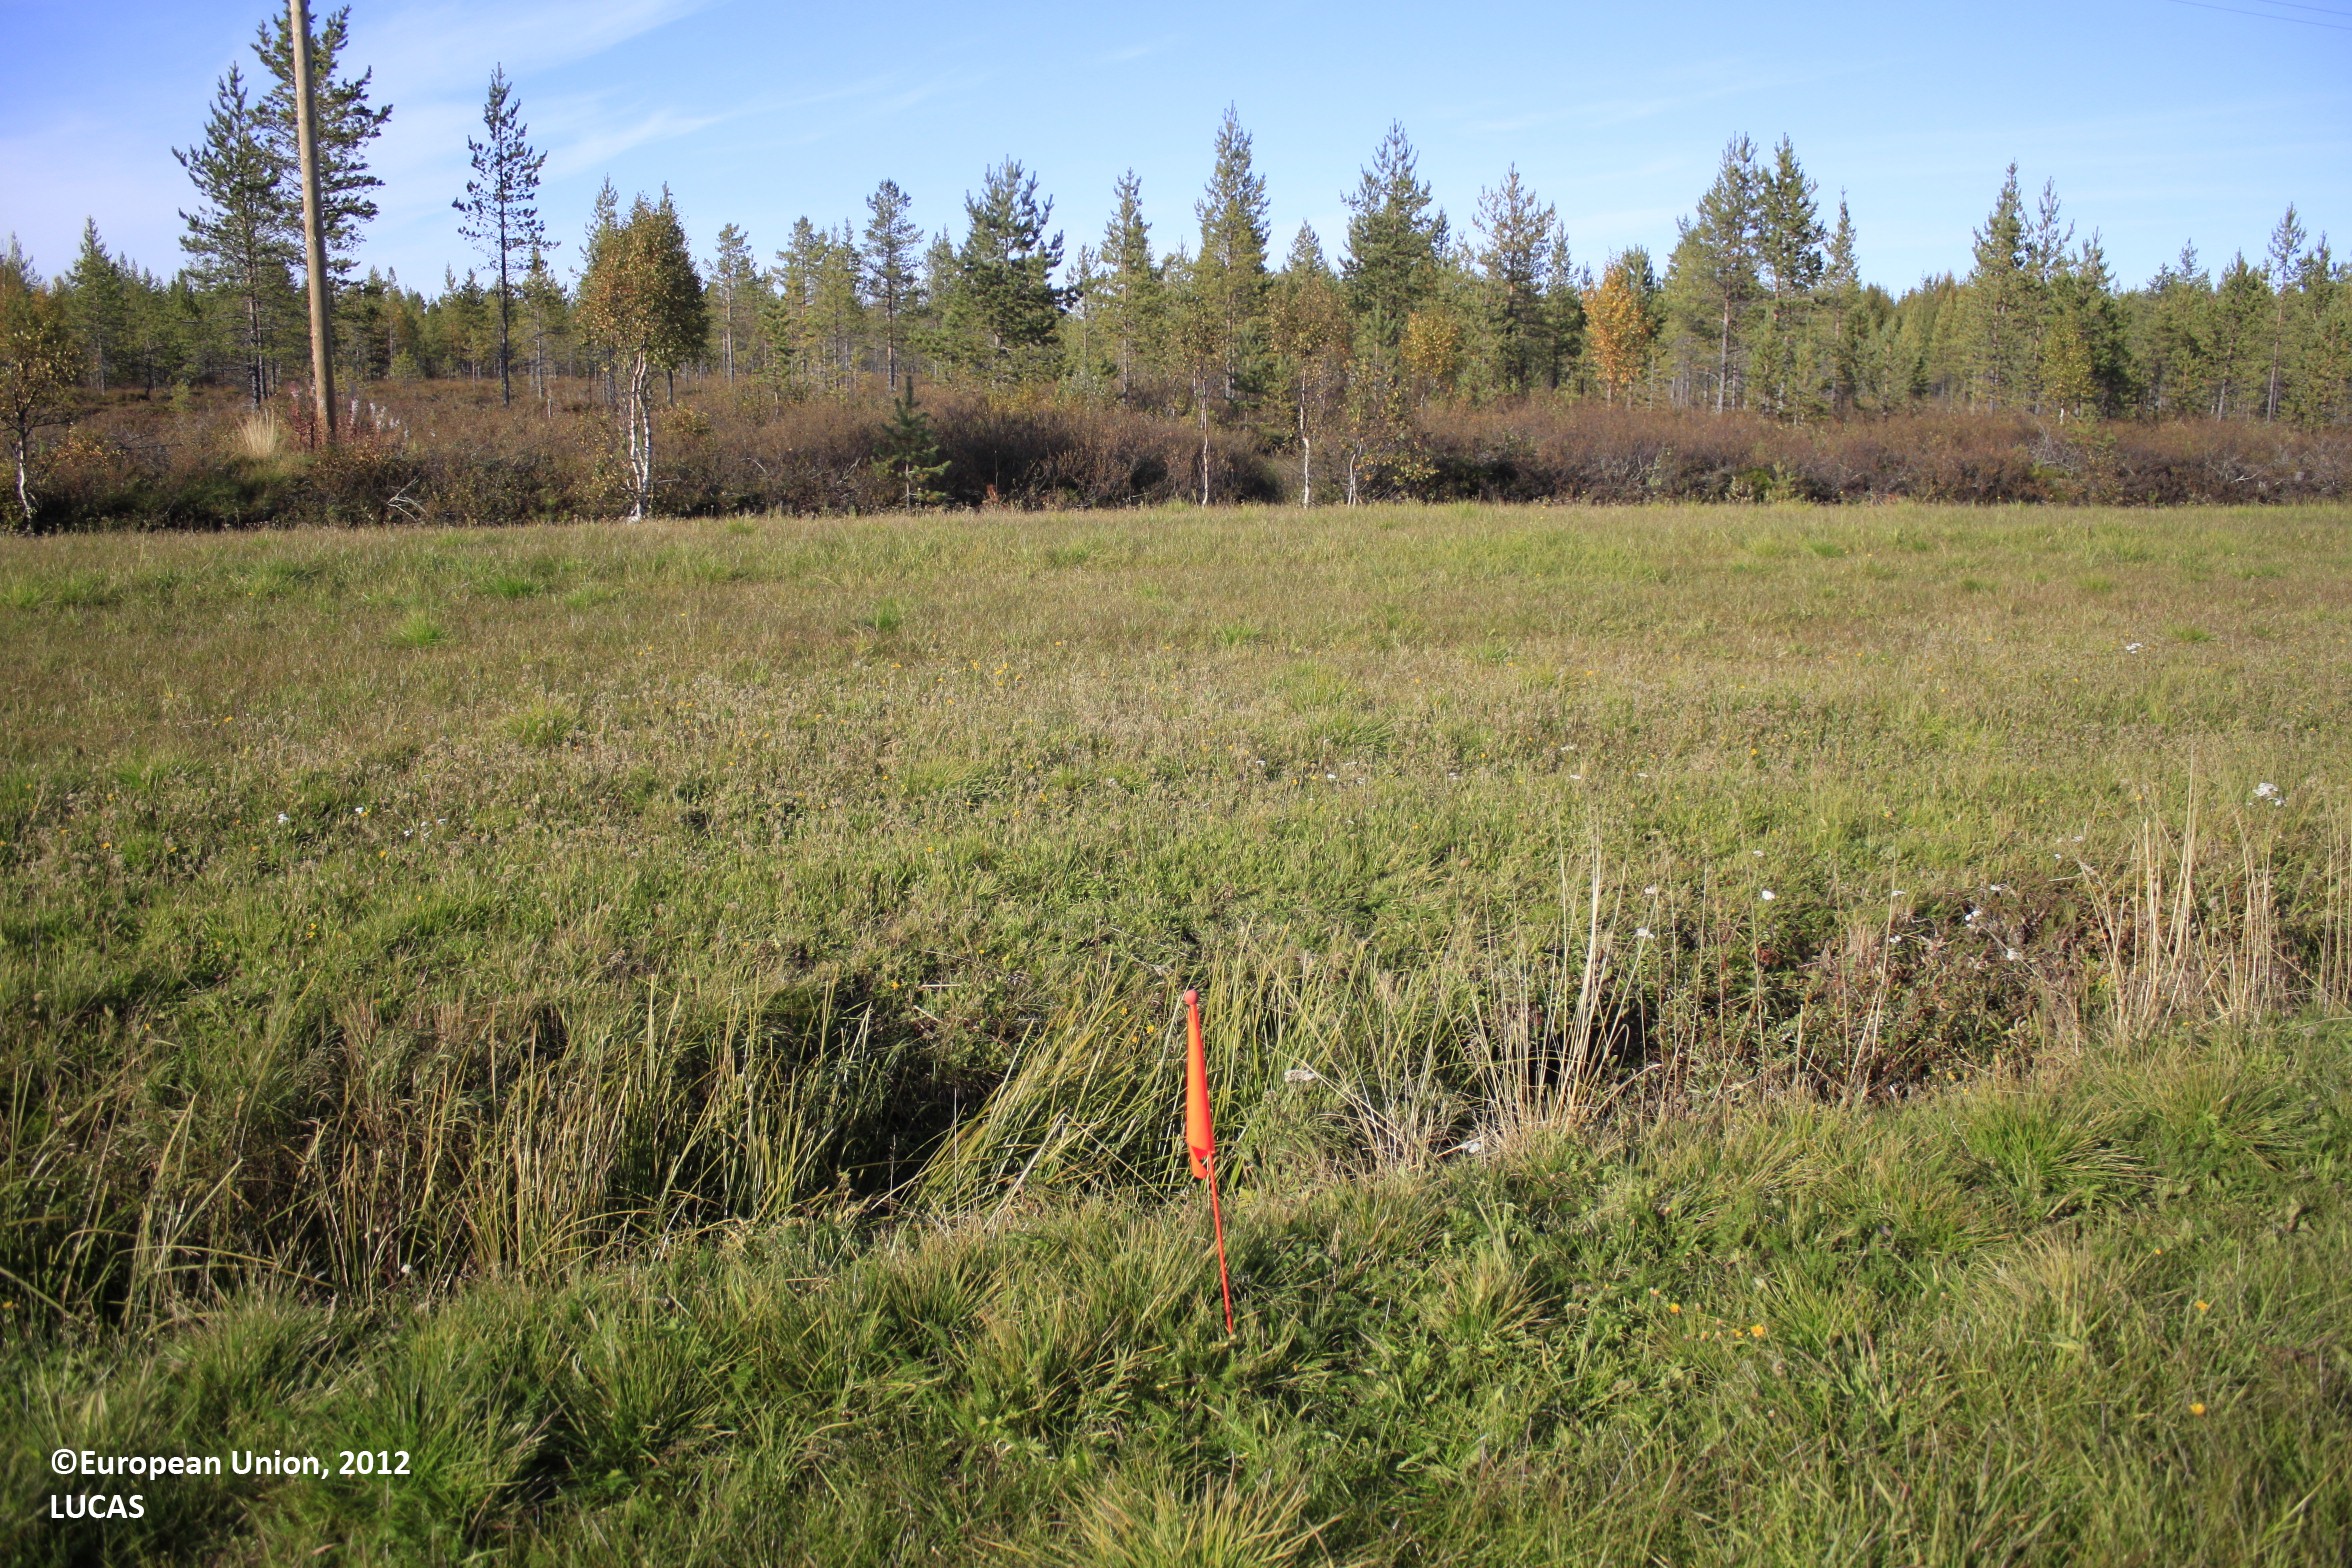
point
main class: Grassland
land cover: Grassland without tree/shrub cover
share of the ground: > 75 %
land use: Fallow land
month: September
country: FI
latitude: 65.8548
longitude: 26.7763
